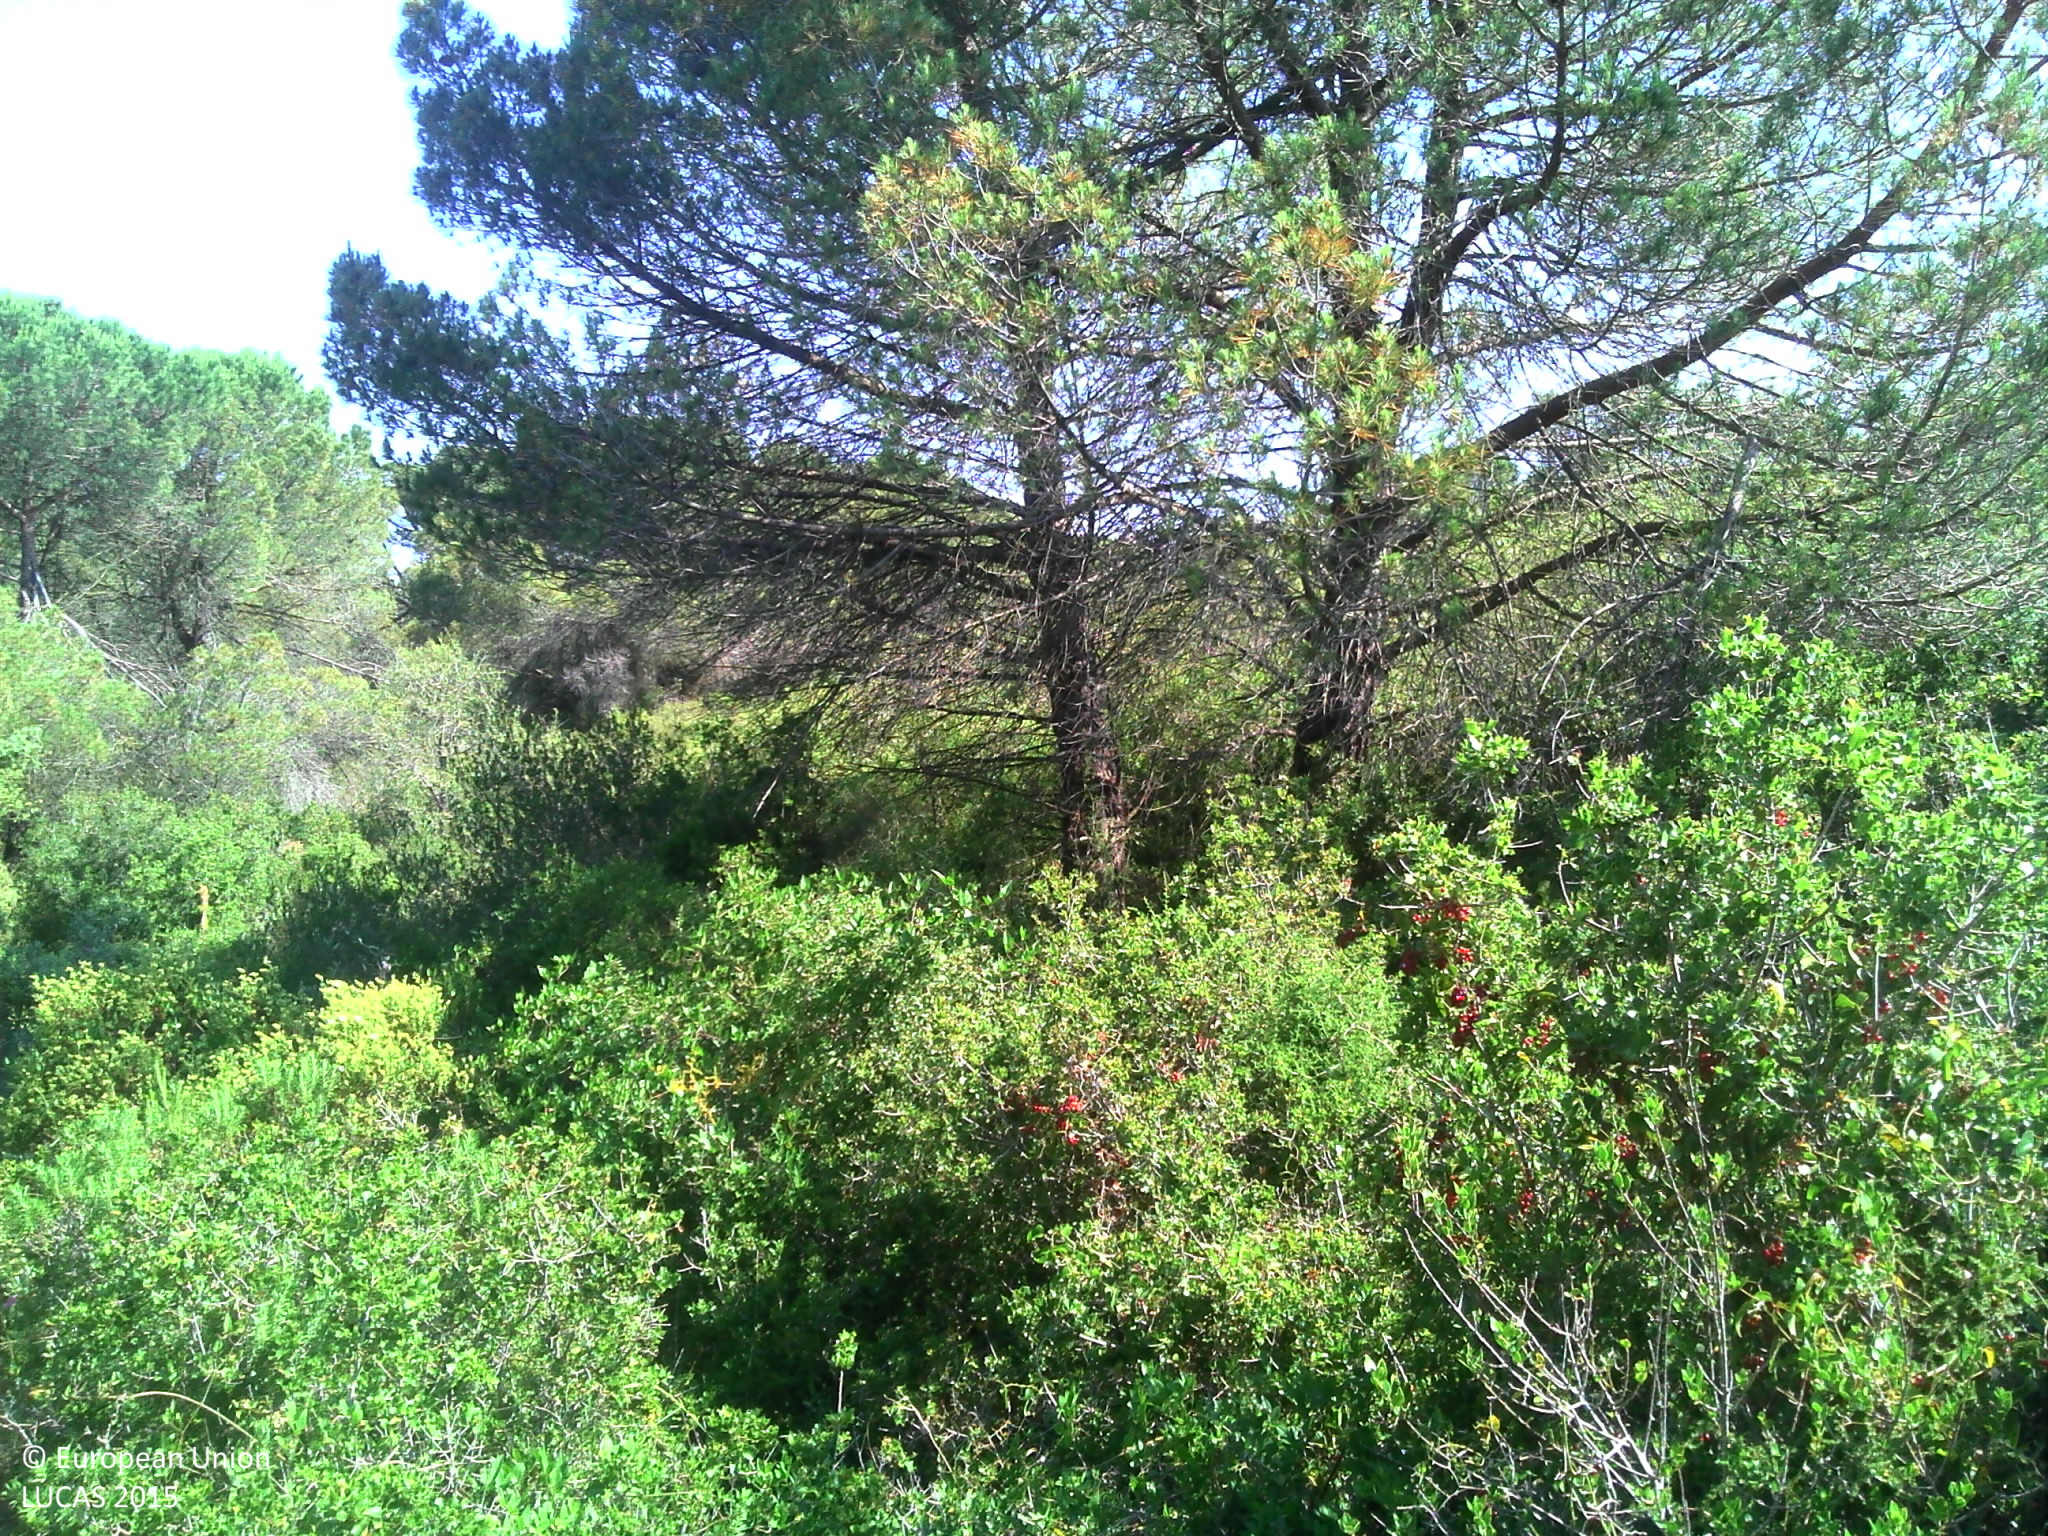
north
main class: Shrubland
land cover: Shrubland with sparse tree cover
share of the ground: > 75 %
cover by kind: shrubs 95 %, coniferous forest trees 5 %
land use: Semi-natural and natural areas not in use
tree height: > 5 m
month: June
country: FR
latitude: 43.1979
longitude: 3.1060
